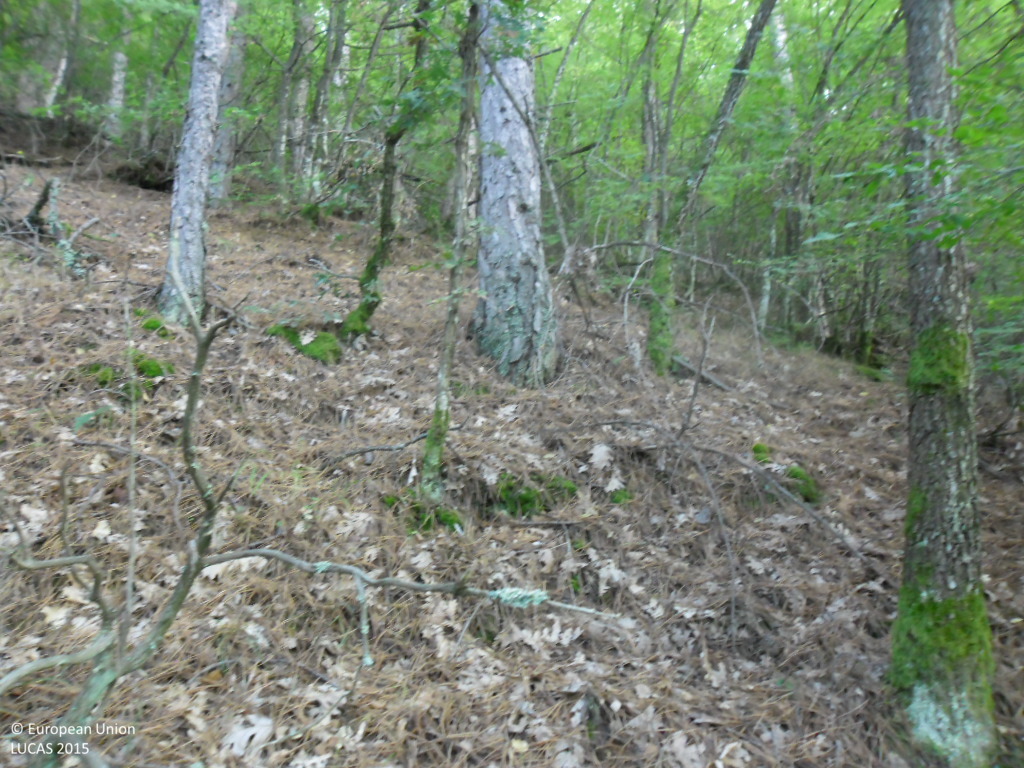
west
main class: Woodland
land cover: Pine dominated mixed woodland
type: hemiboreal forest and nemoral coniferous forest and mixed broadleaved-coniferous forest
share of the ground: > 75 %
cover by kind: coniferous forest trees 65 %, broadleaved forest trees 35 %
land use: Forestry
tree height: > 5 m
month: September
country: BG
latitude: 41.8946
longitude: 22.9295
